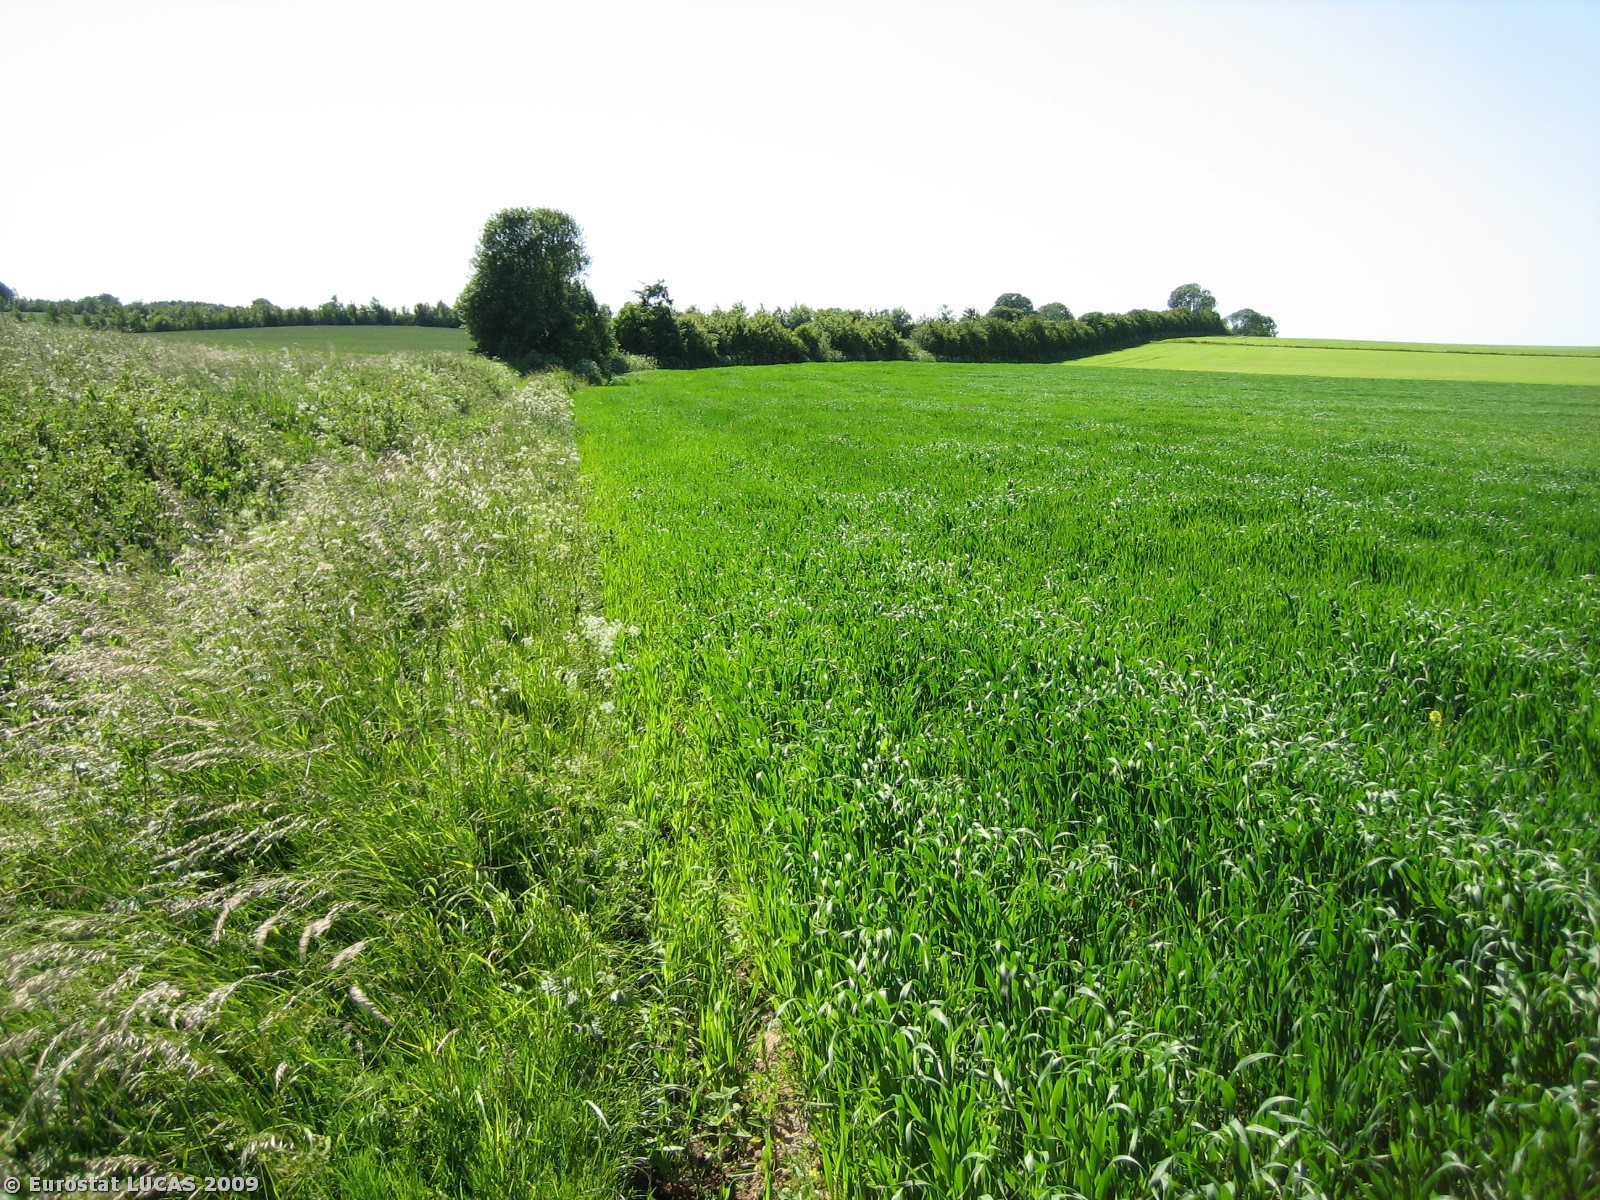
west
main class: Cropland
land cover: Rape and turnip rape
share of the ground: > 75 %
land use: Agriculture (excluding fallow land and kitchen gardens)
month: June
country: DK
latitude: 55.8998
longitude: 9.7284
